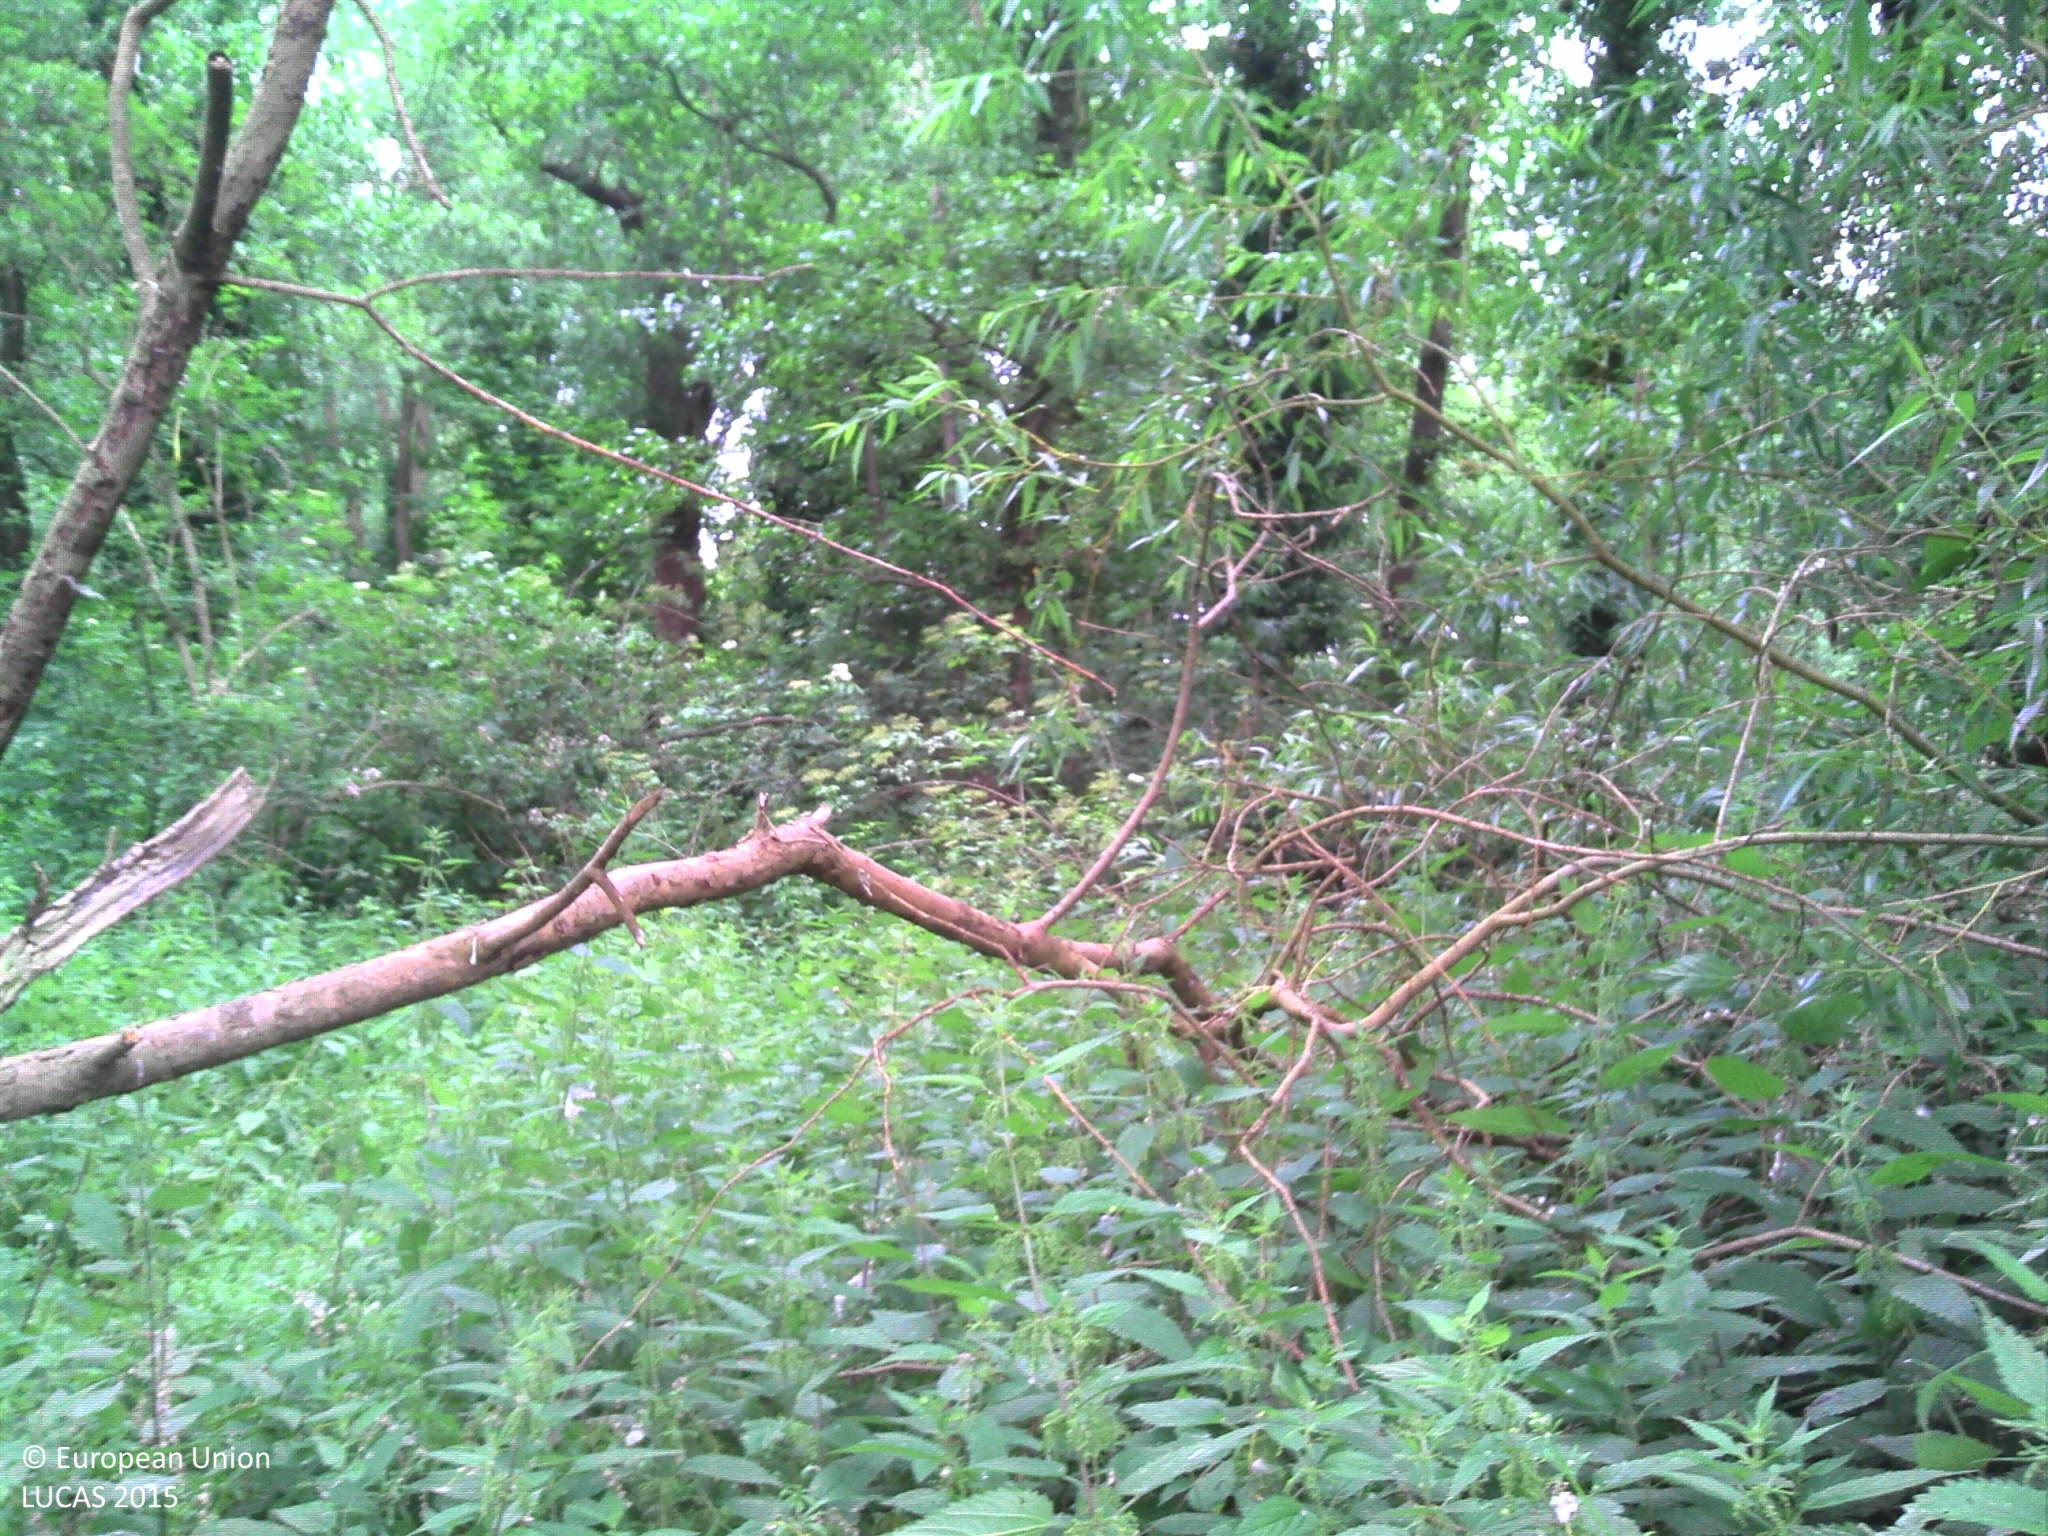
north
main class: Woodland
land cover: Broadleaved woodland
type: floodplain forest
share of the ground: > 75 %
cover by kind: broadleaved forest trees 100 %
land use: Forestry
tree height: > 5 m
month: June
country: BE
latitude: 51.0592
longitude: 3.7581
